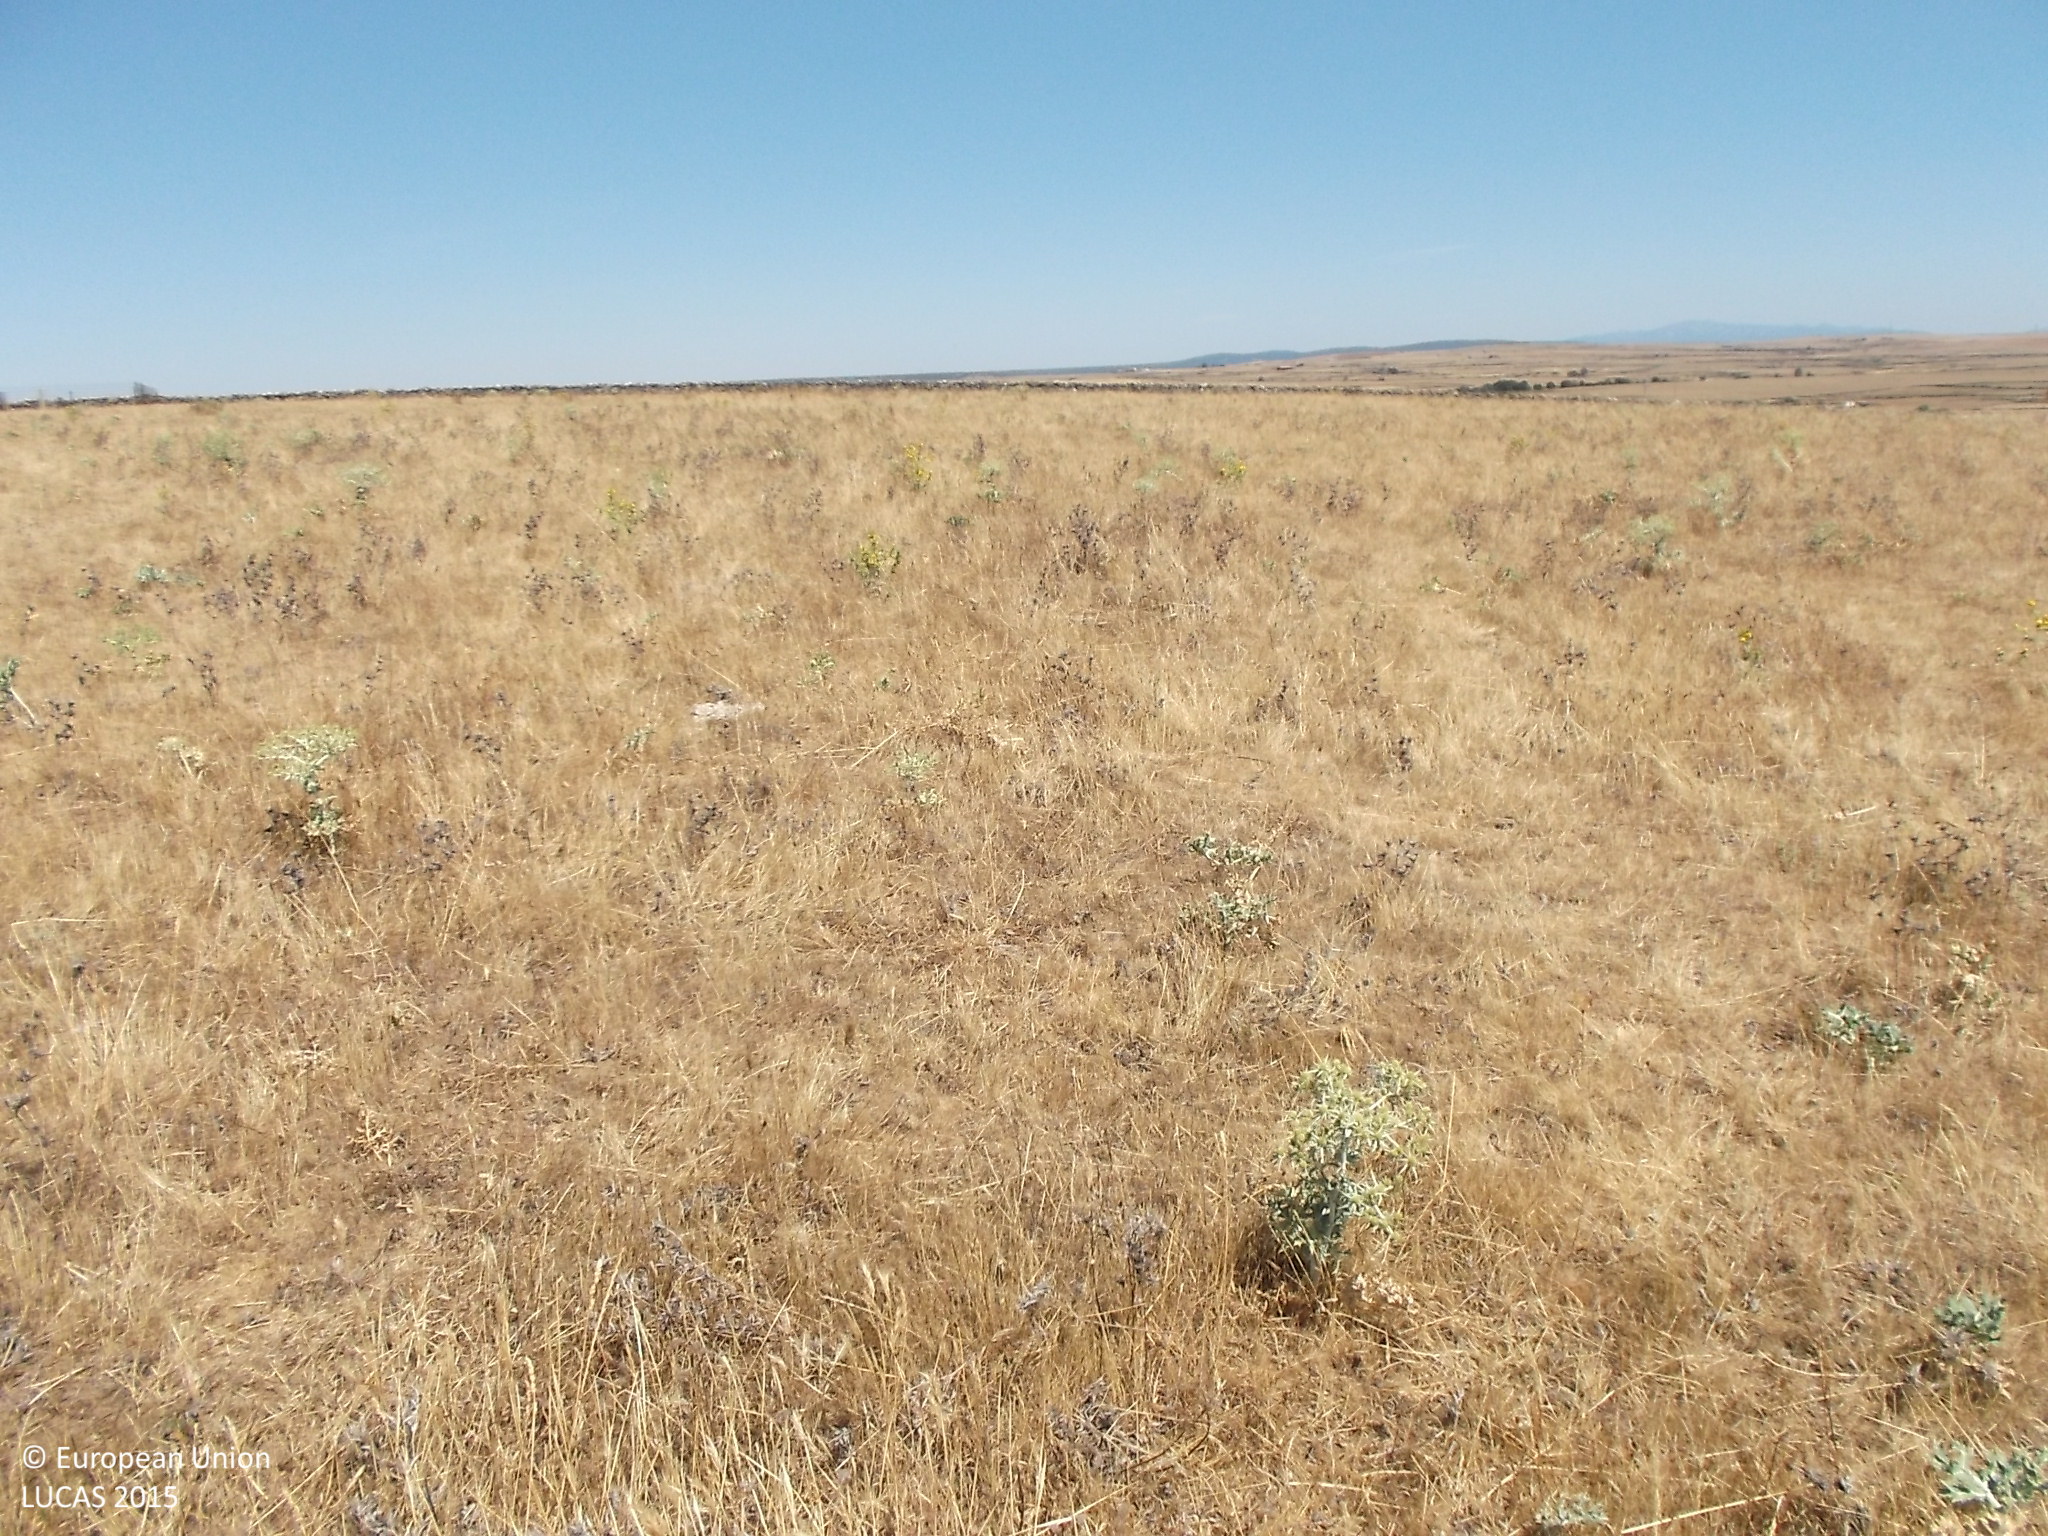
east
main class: Grassland
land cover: Grassland without tree/shrub cover
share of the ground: > 75 %
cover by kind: herbaceous plants 100 %
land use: Agriculture (excluding fallow land and kitchen gardens)
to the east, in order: Grassland without tree/shrub cover; Dry stone walls; Grassland without tree/shrub cover; Fences; Grassland without tree/shrub cover
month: July
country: ES
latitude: 40.7309
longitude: -6.7564
